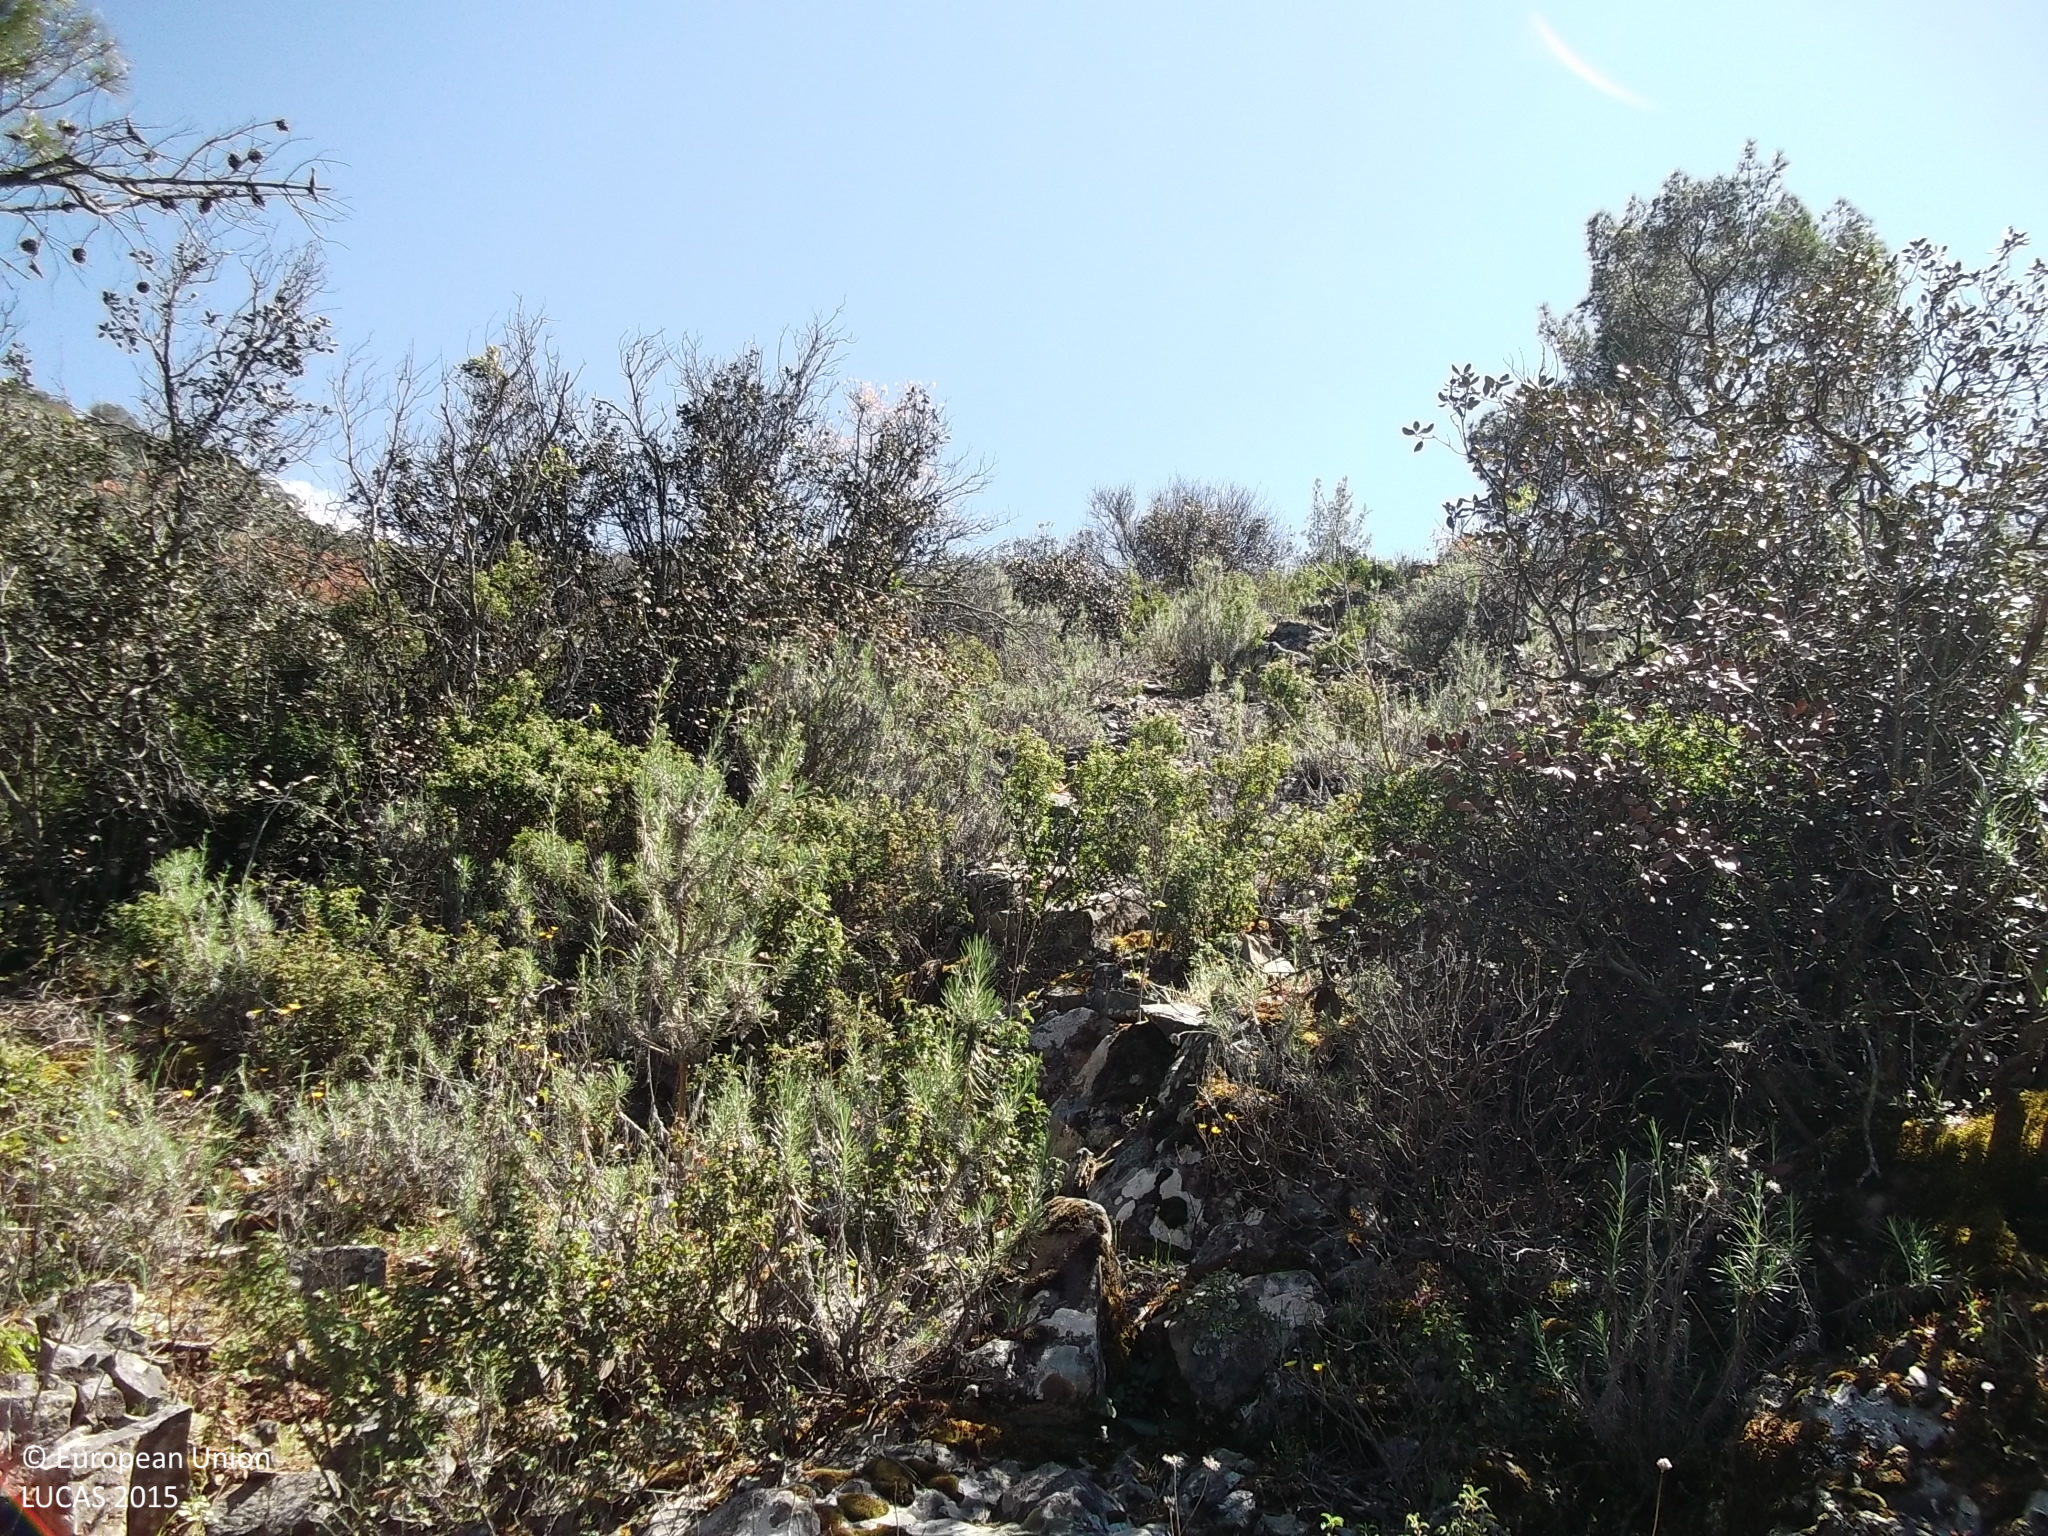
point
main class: Shrubland
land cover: Shrubland with sparse tree cover
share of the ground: > 75 %
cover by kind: shrubs 75 %, consolidated bare surface 10 %, unconsolidated bare surface 10 %, coniferous forest trees 5 %
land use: Semi-natural and natural areas not in use
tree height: > 5 m
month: April
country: CY
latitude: 34.9178
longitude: 33.1752
